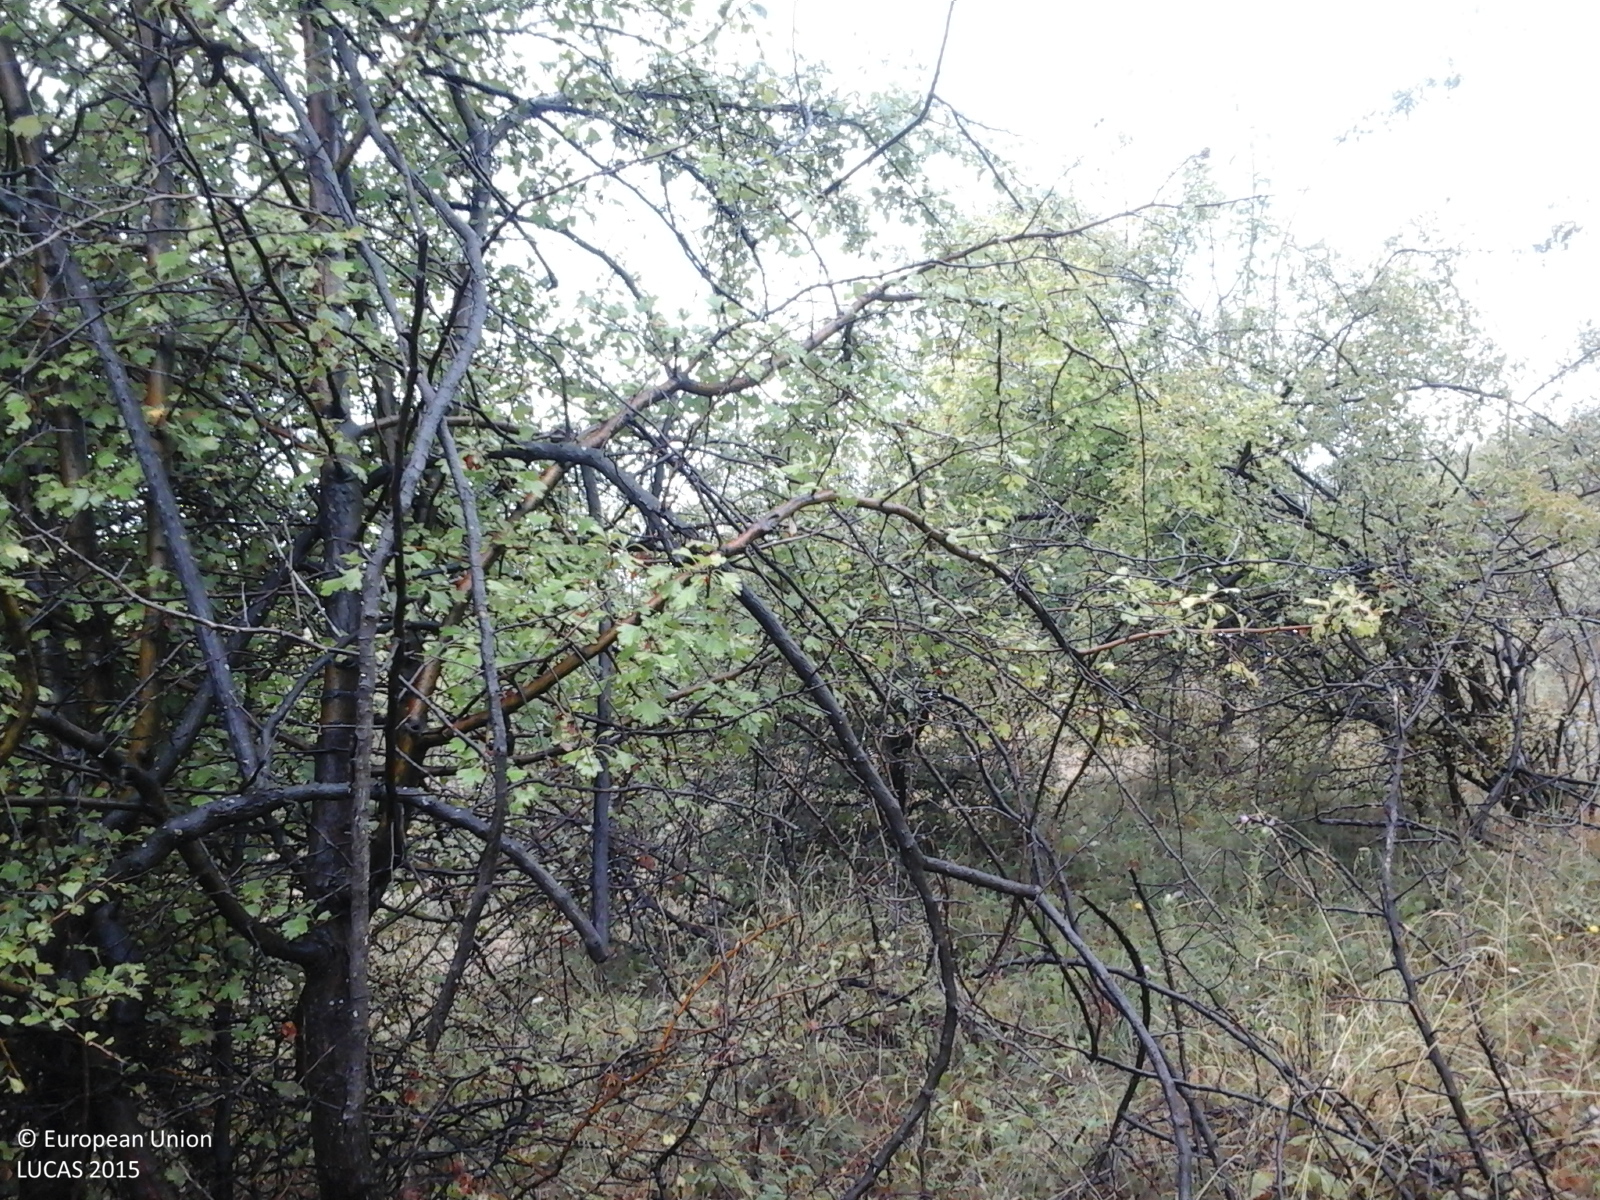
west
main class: Shrubland
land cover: Shrubland without tree cover
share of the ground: > 75 %
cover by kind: shrubs 100 %
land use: Semi-natural and natural areas not in use
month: August
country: RO
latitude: 44.5695
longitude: 22.8498
